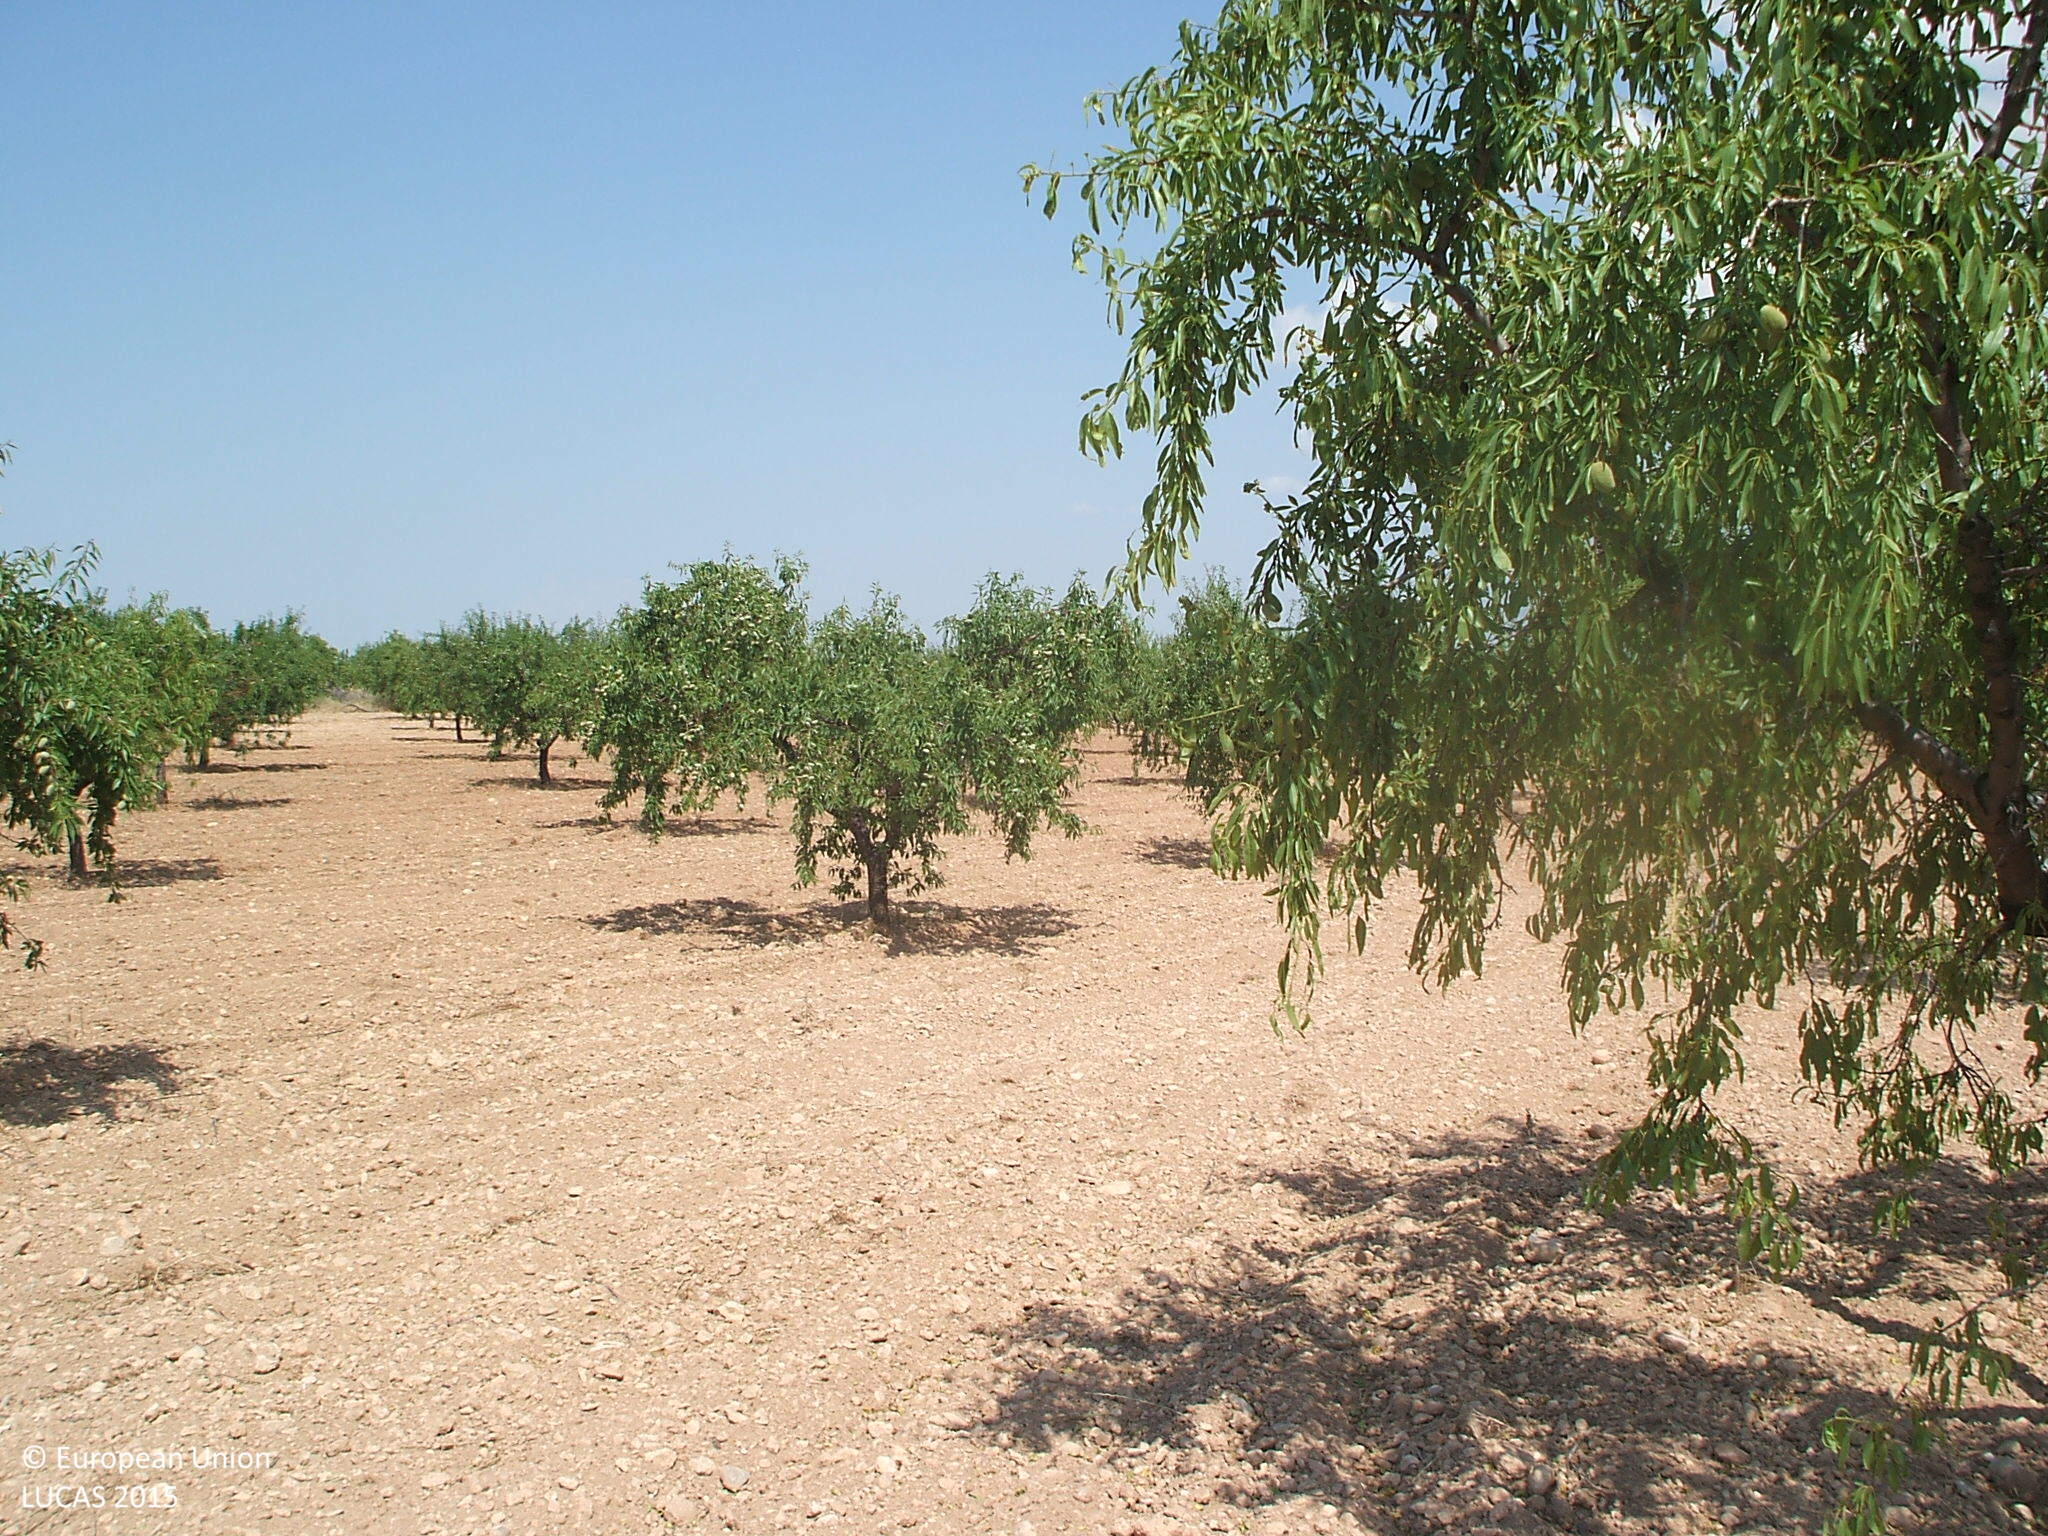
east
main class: Cropland
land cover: Nuts trees
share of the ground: 25 - 50 %
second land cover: Other bare soil
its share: > 75 %
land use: Agriculture (excluding fallow land and kitchen gardens)
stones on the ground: > 50 %
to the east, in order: Nuts trees; Other bare soil; Olive groves; Electric lines; Olive groves; Nuts trees; Grass margins; Durum wheat
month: June
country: ES
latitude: 40.9508
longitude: -0.2395
